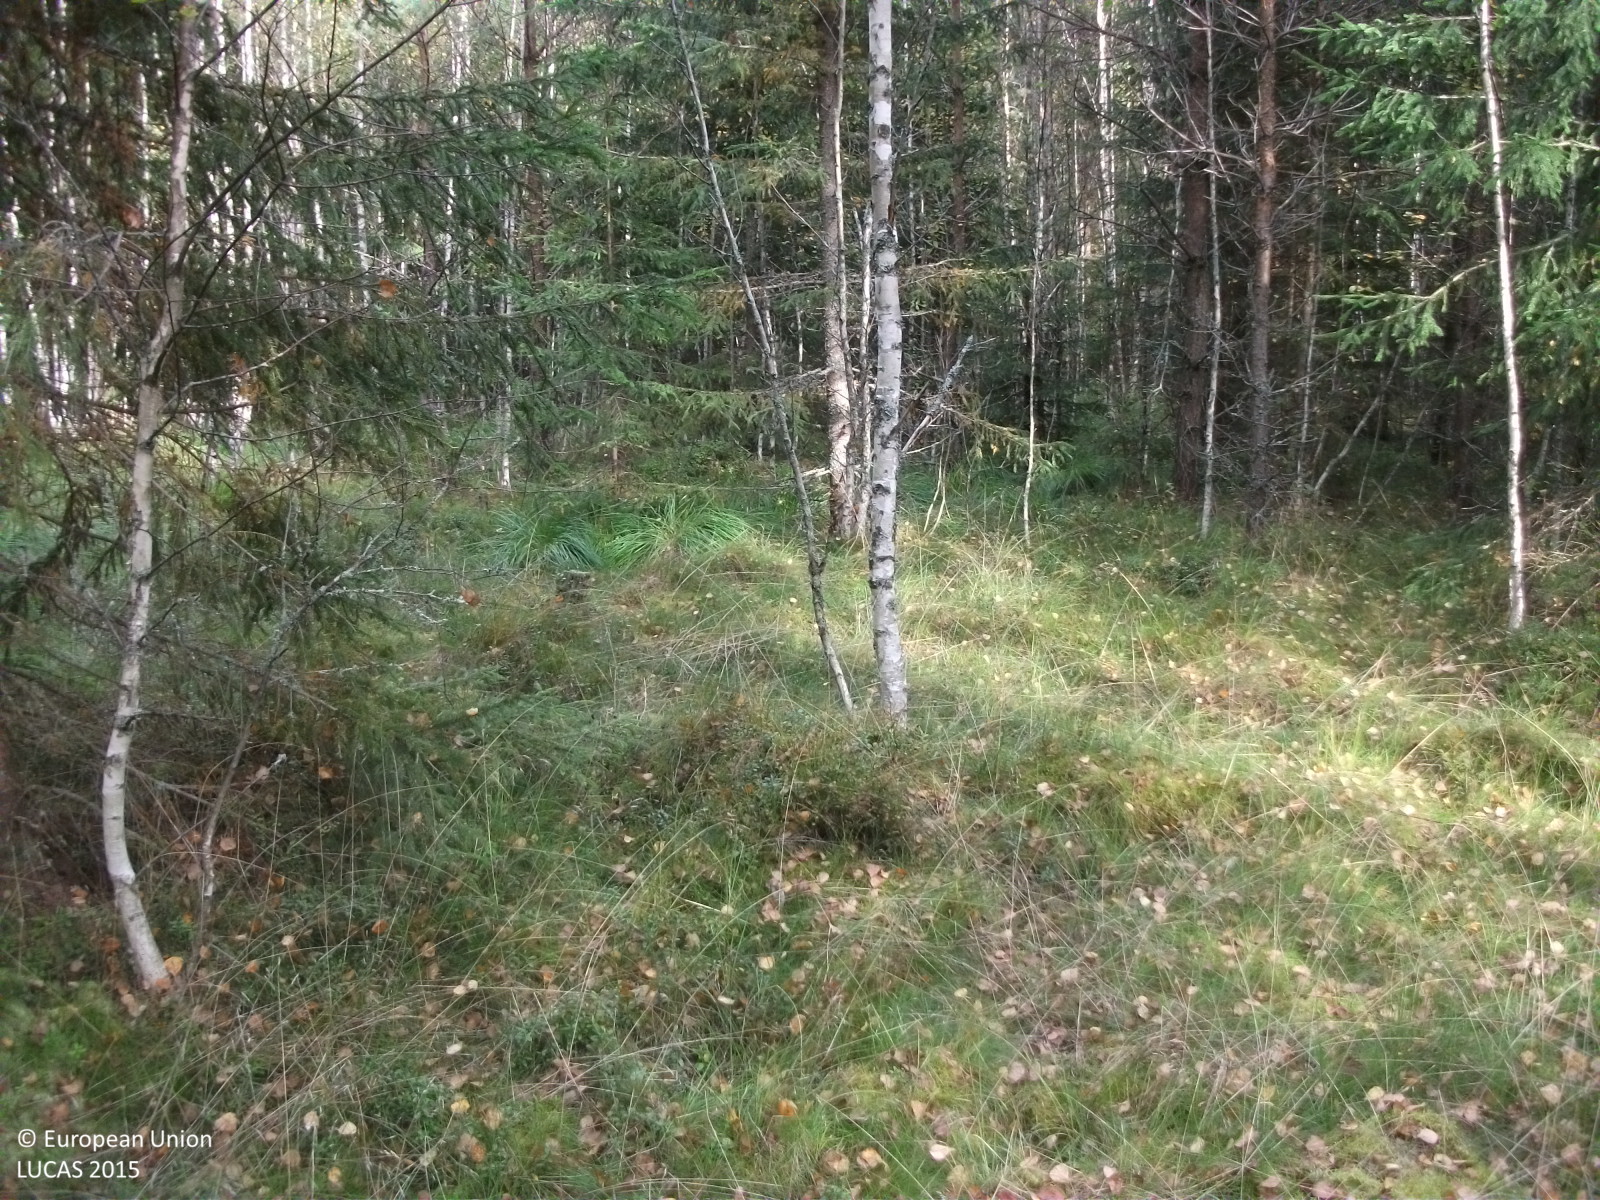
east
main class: Woodland
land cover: Spruce dominated mixed woodland
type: hemiboreal forest and nemoral coniferous forest and mixed broadleaved-coniferous forest
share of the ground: > 75 %
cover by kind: broadleaved forest trees 55 %, coniferous forest trees 30 %, herbaceous plants 15 %
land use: Forestry
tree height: > 5 m
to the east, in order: Spruce dominated mixed woodland; Other mixed woodland; Spruce dominated mixed woodland; Broadleaved woodland; Spontaneously vegetated surfaces
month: September
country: LV
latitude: 57.8125
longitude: 24.8241
